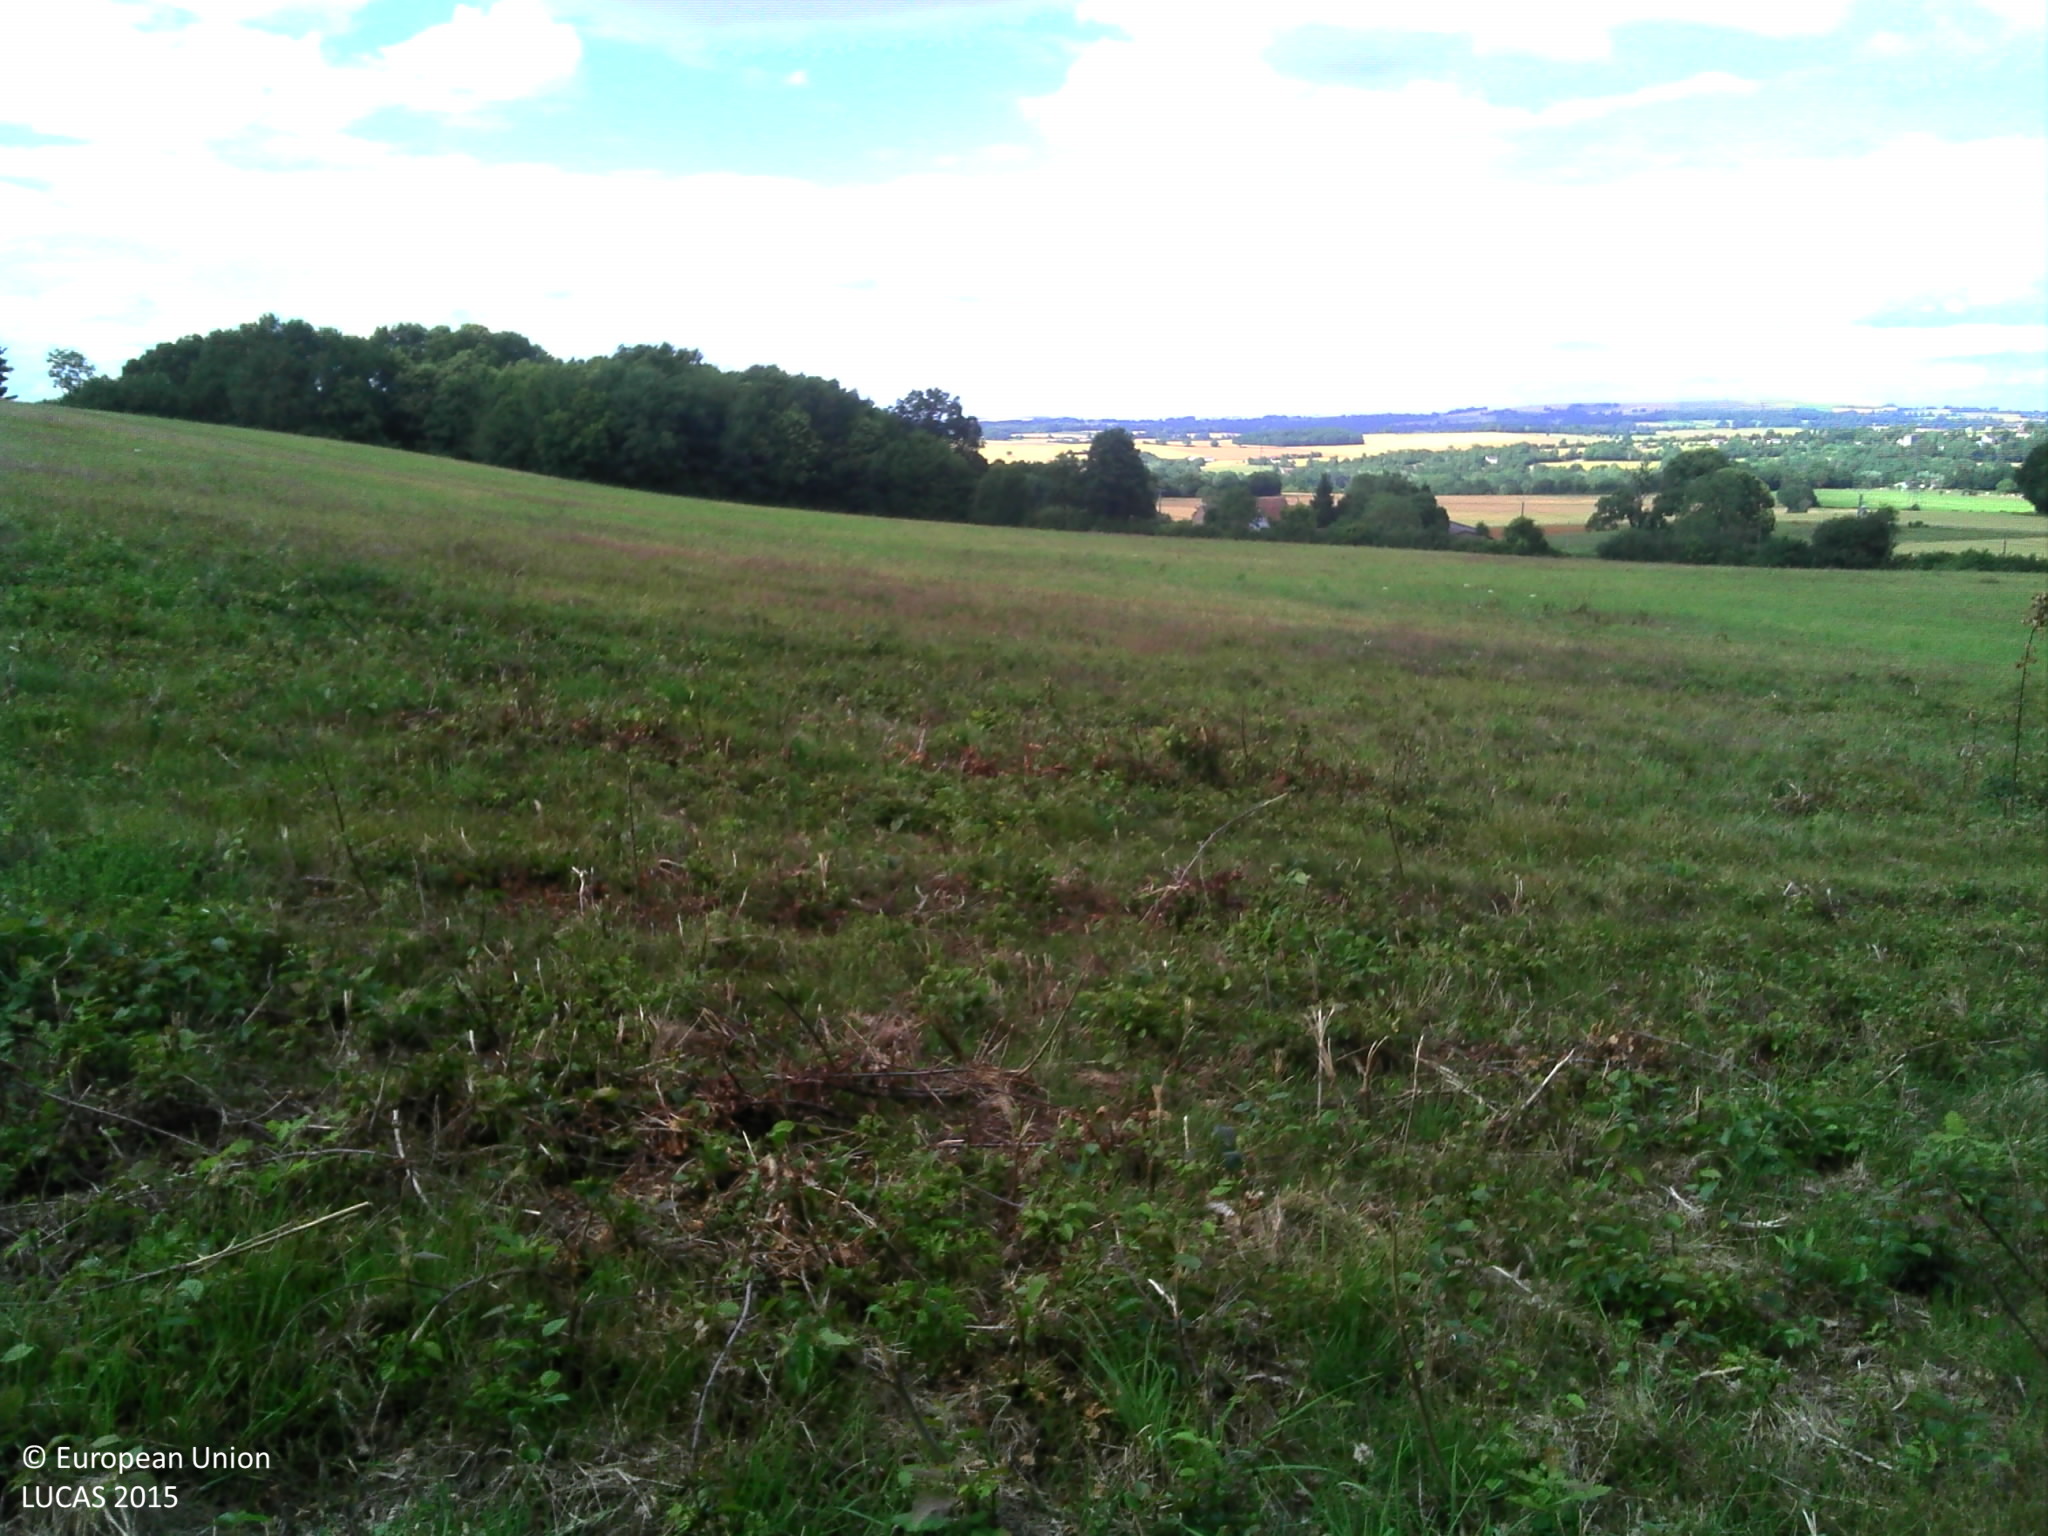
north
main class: Grassland
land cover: Grassland without tree/shrub cover
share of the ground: > 75 %
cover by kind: herbaceous plants 100 %
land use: Agriculture (excluding fallow land and kitchen gardens)
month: June
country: FR
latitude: 47.3113
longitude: 2.6783
